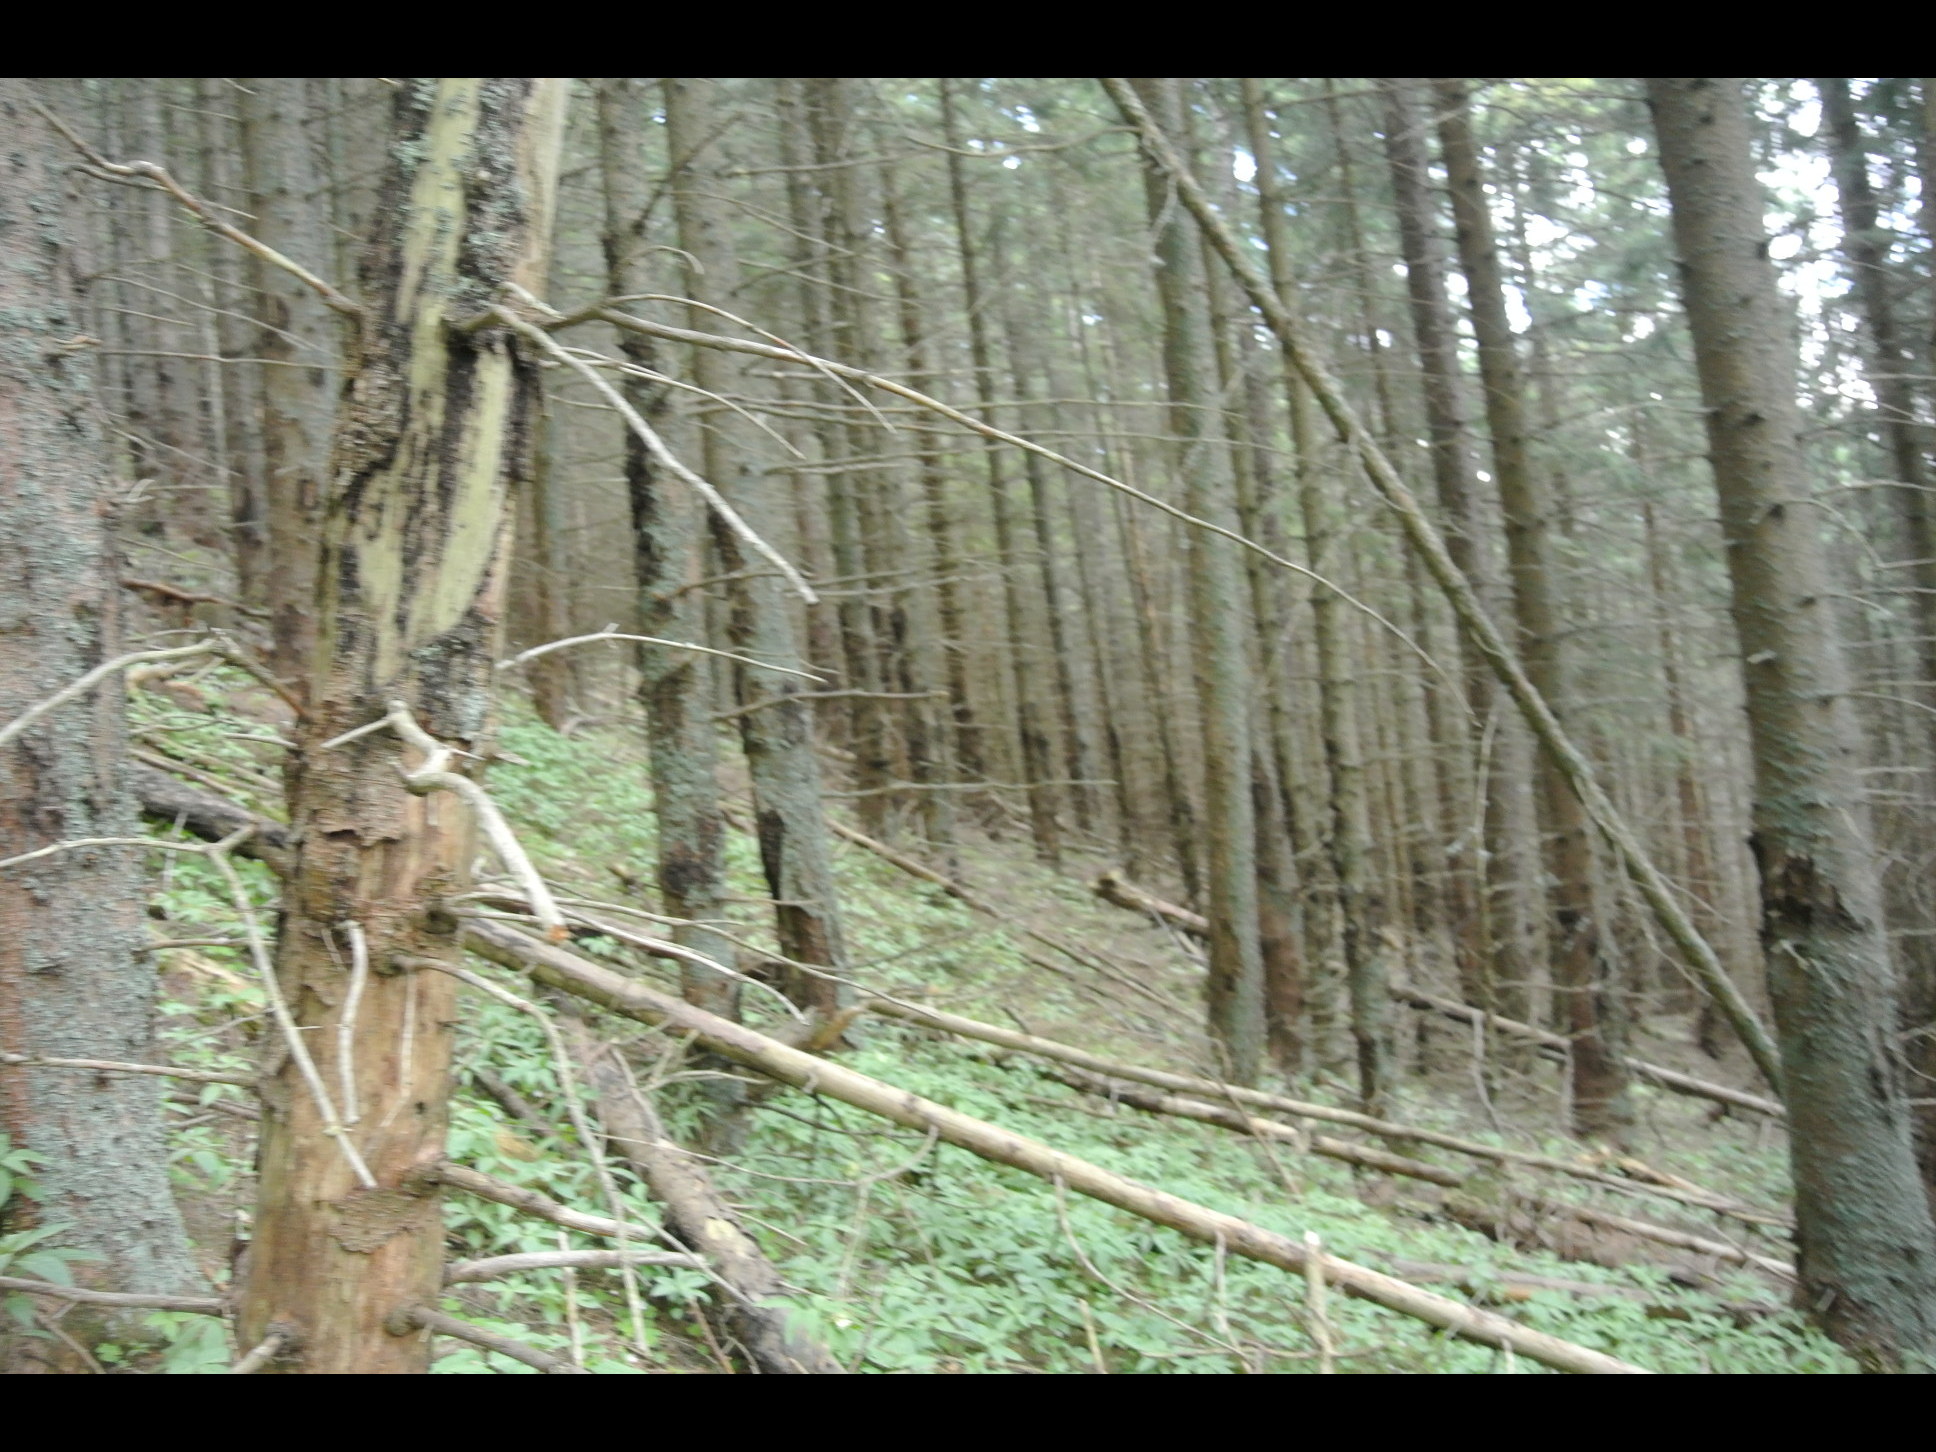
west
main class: Woodland
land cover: Spruce dominated coniferous woodland
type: alpine coniferous forest
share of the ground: > 75 %
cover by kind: coniferous forest trees 100 %
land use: Forestry
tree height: > 5 m
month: May
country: AT
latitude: 47.6576
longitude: 15.7673
